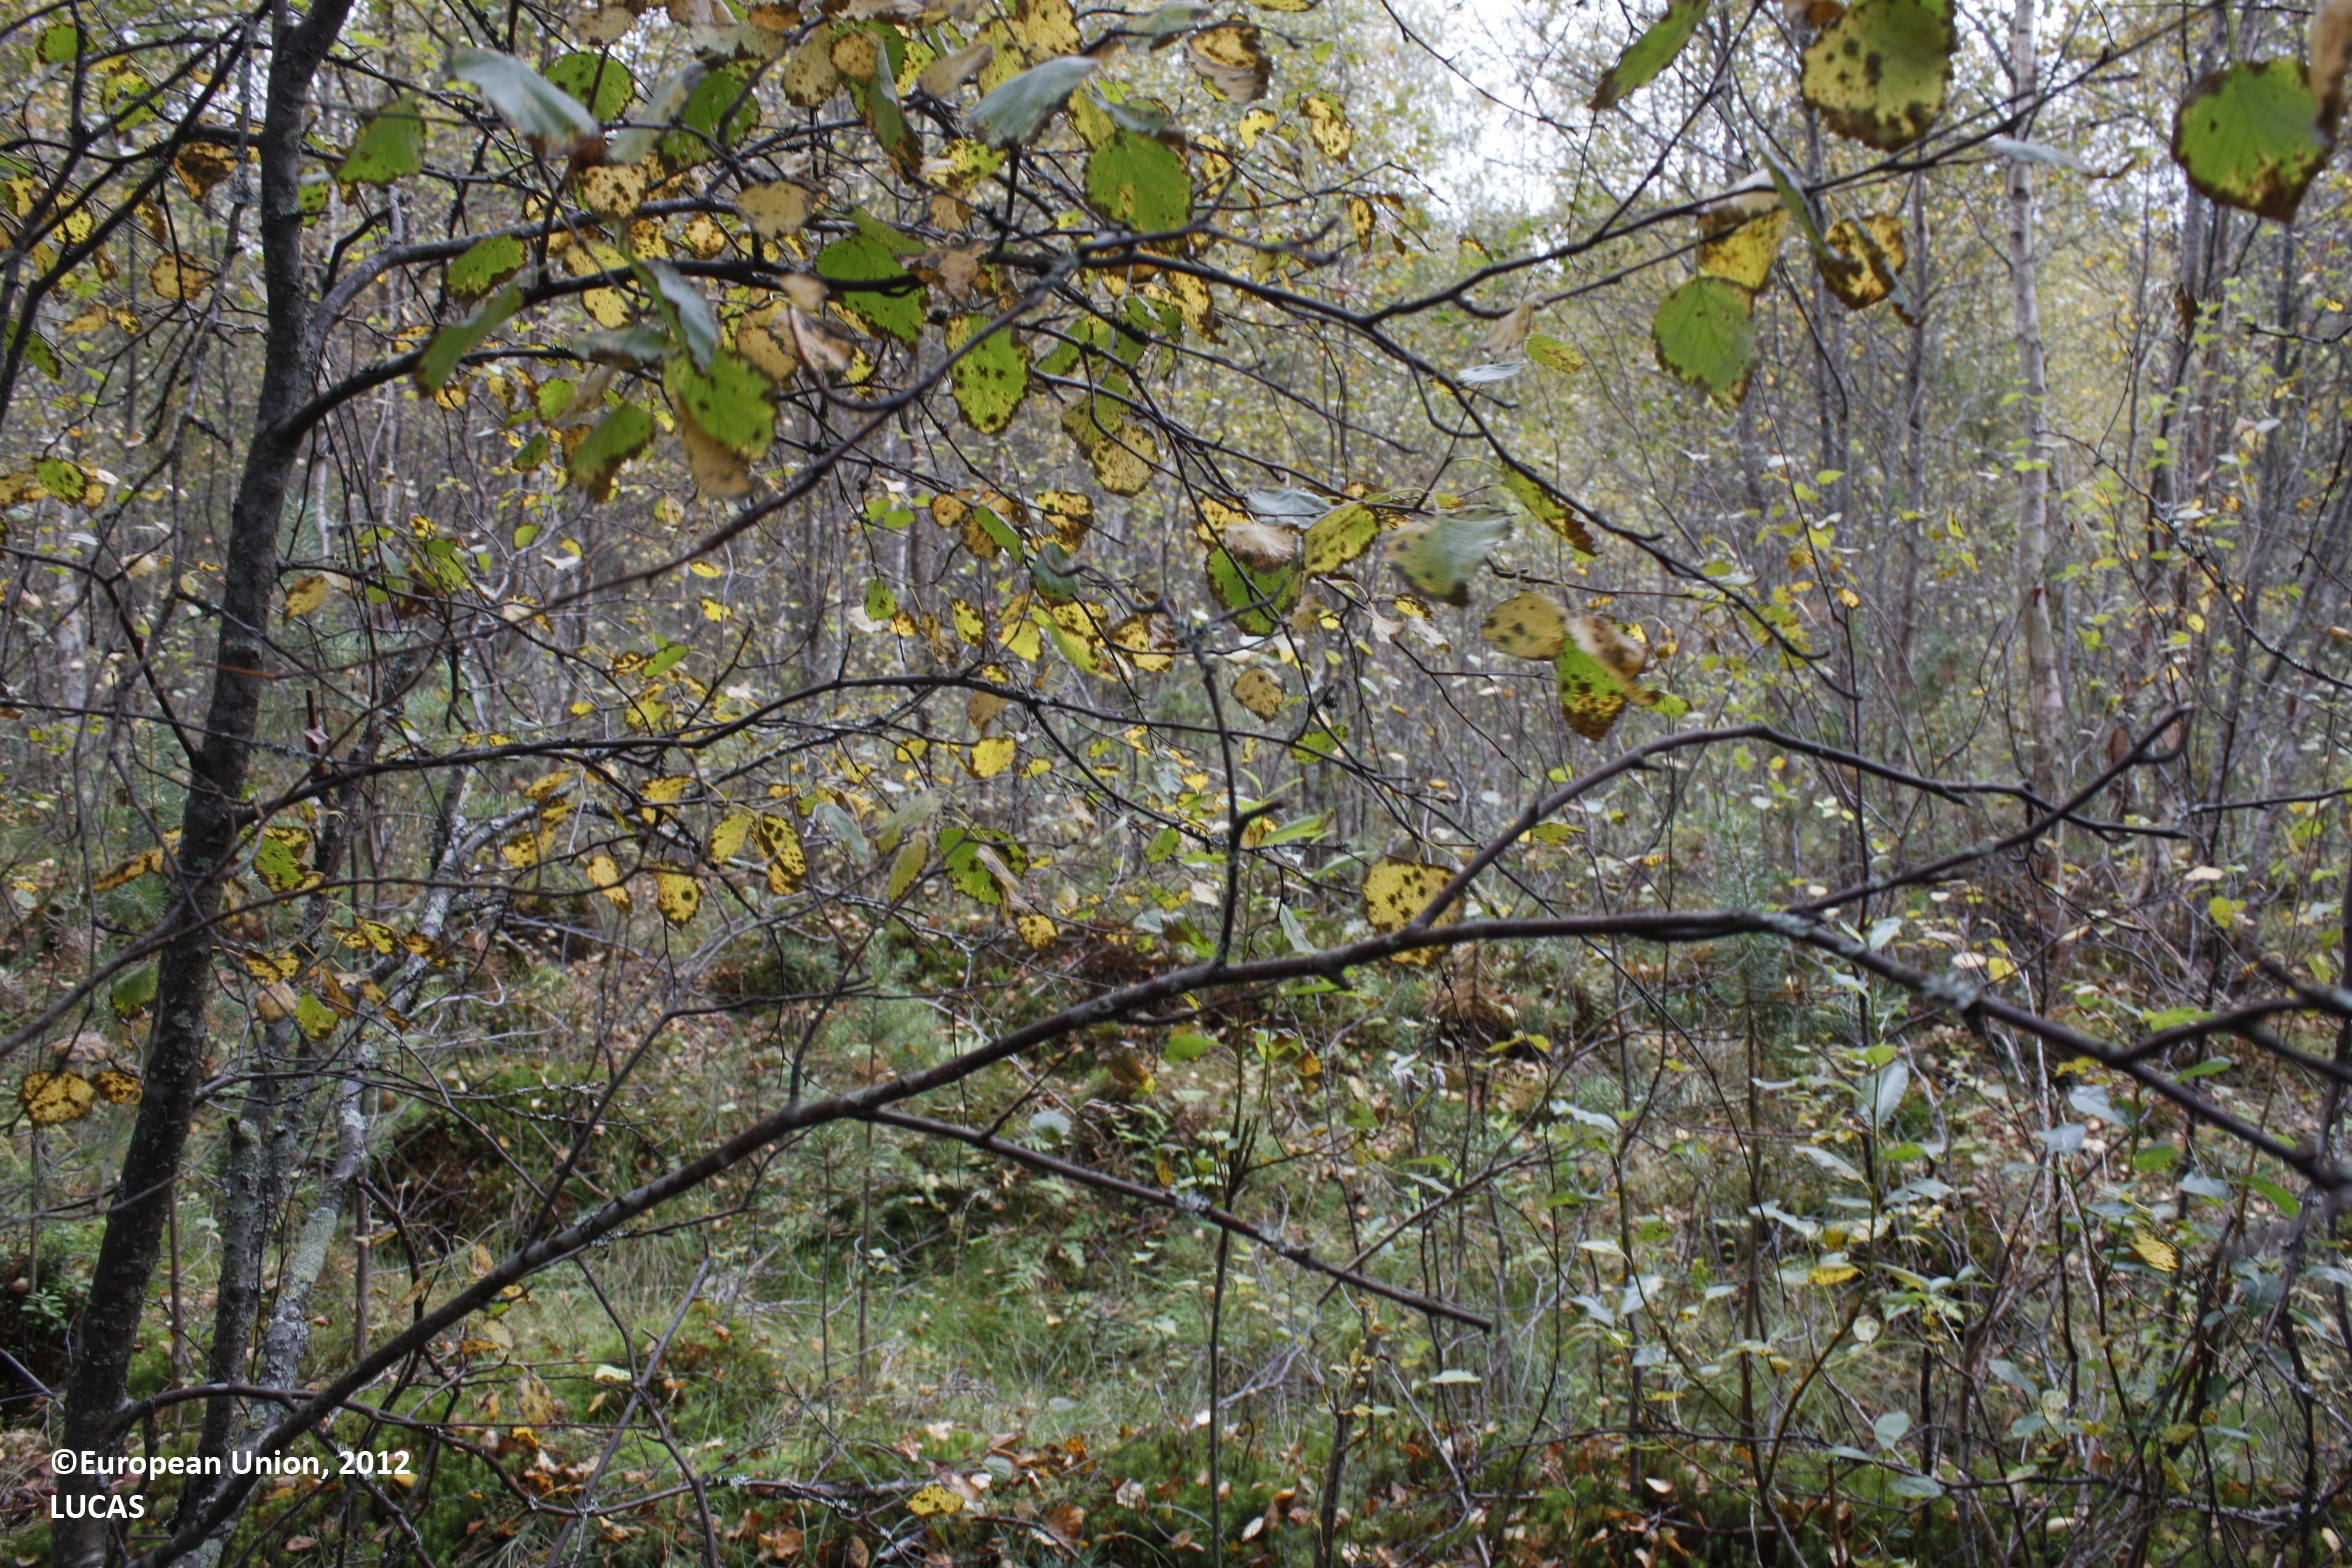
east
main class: Woodland
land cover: Pine dominated mixed woodland
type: boreal forest
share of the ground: > 75 %
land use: Forestry
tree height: > 5 m
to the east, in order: Pine dominated mixed woodland; Ditches and canals; Broadleaved woodland; Ditches and canals; Broadleaved woodland; Ditches and canals; Pine dominated coniferous woodland; Tracks; Pine dominated coniferous woodland; Ditches and canals; Pine dominated coniferous woodland; Ditches and canals; Pine dominated coniferous woodland; Electric lines; Pine dominated coniferous woodland
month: September
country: FI
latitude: 65.3841
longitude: 27.0066
